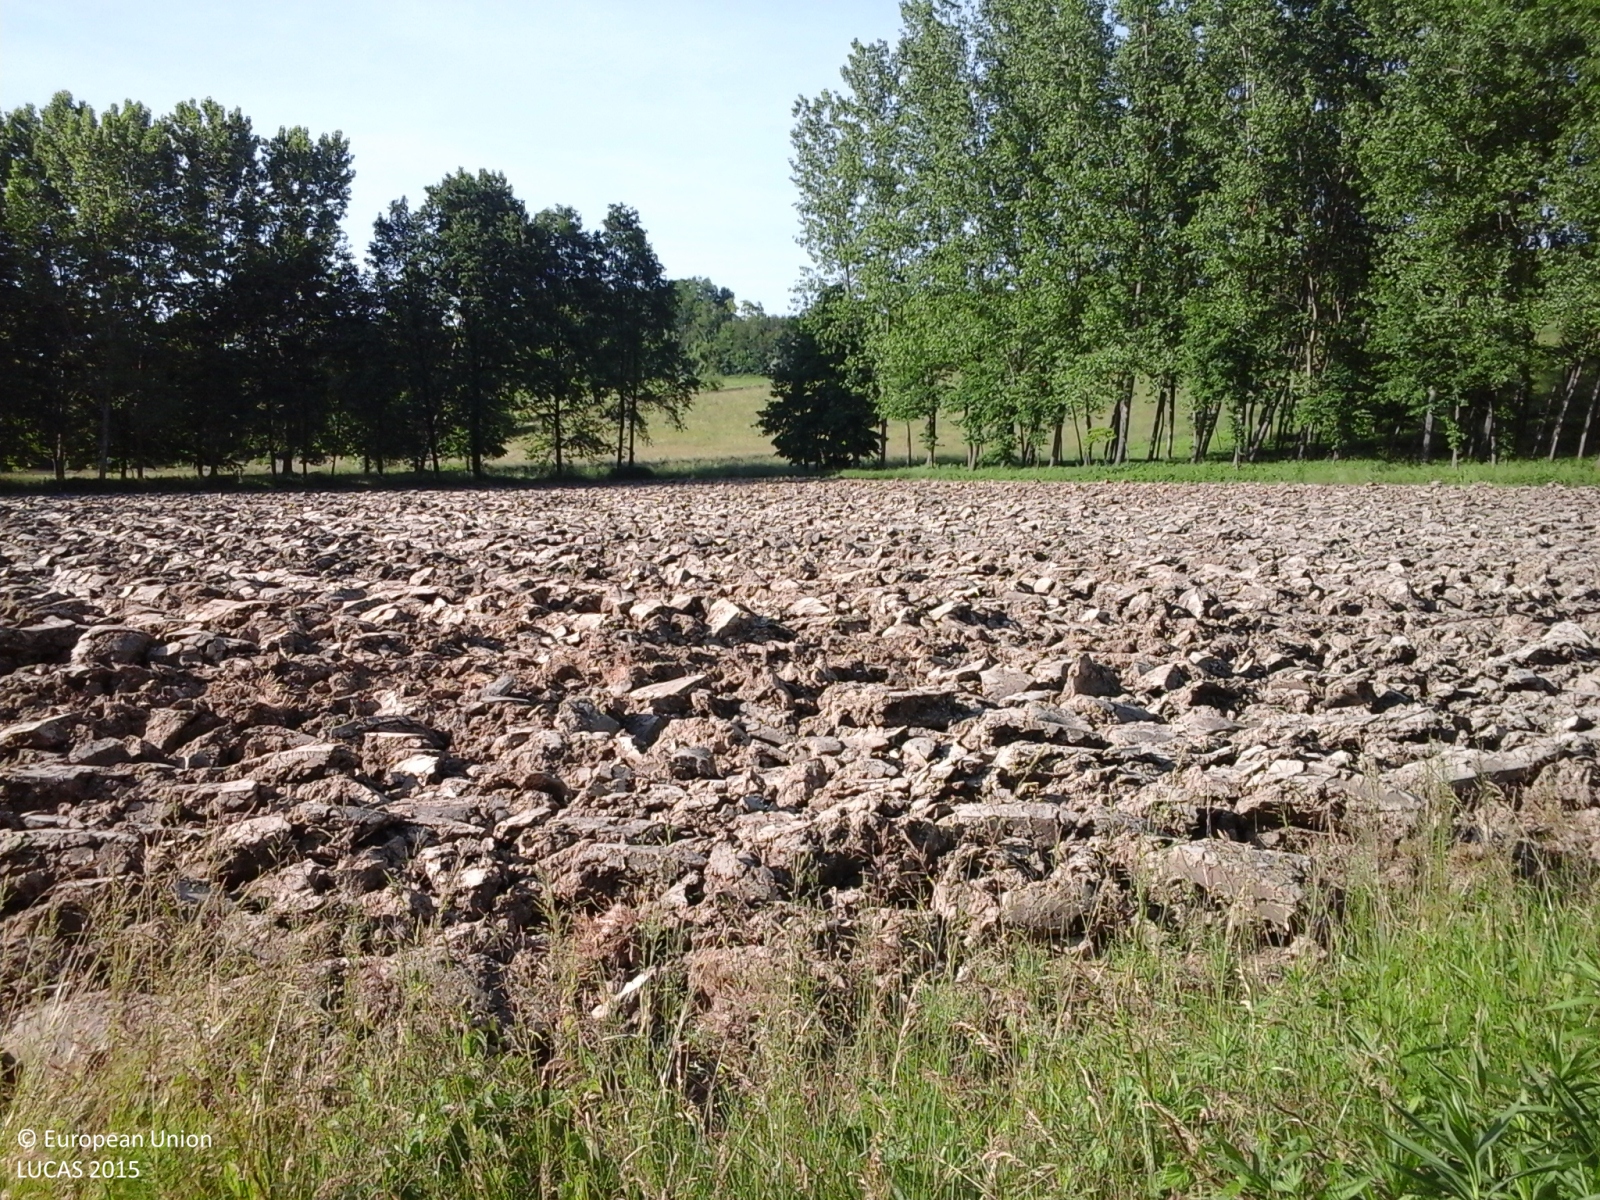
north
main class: Grassland
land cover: Spontaneously vegetated surfaces
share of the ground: > 75 %
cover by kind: herbaceous plants 100 %
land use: Agriculture (excluding fallow land and kitchen gardens)
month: May
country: IT
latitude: 45.0188
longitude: 8.1127
